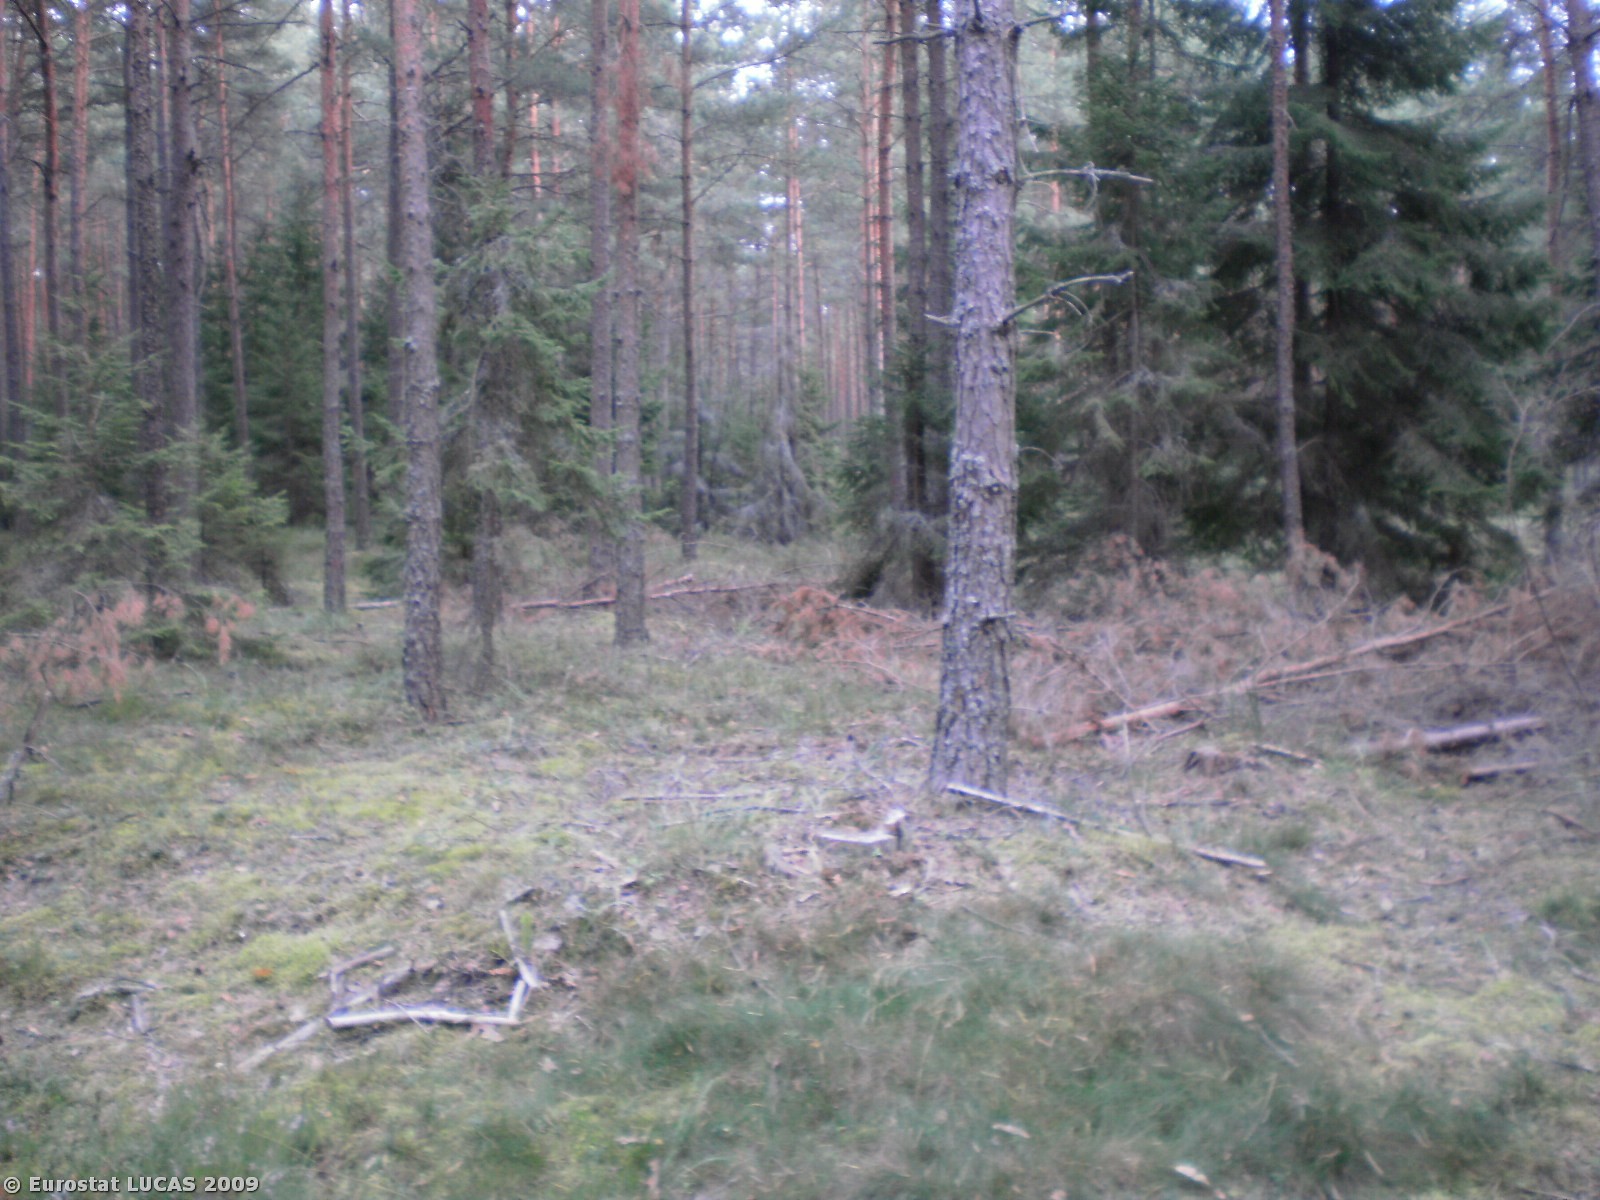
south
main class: Woodland
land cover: Coniferous woodland
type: hemiboreal forest and nemoral coniferous forest and mixed broadleaved-coniferous forest
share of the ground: > 75 %
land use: Forestry
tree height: > 5 m
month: September
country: PL
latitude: 53.6220
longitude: 21.6176
